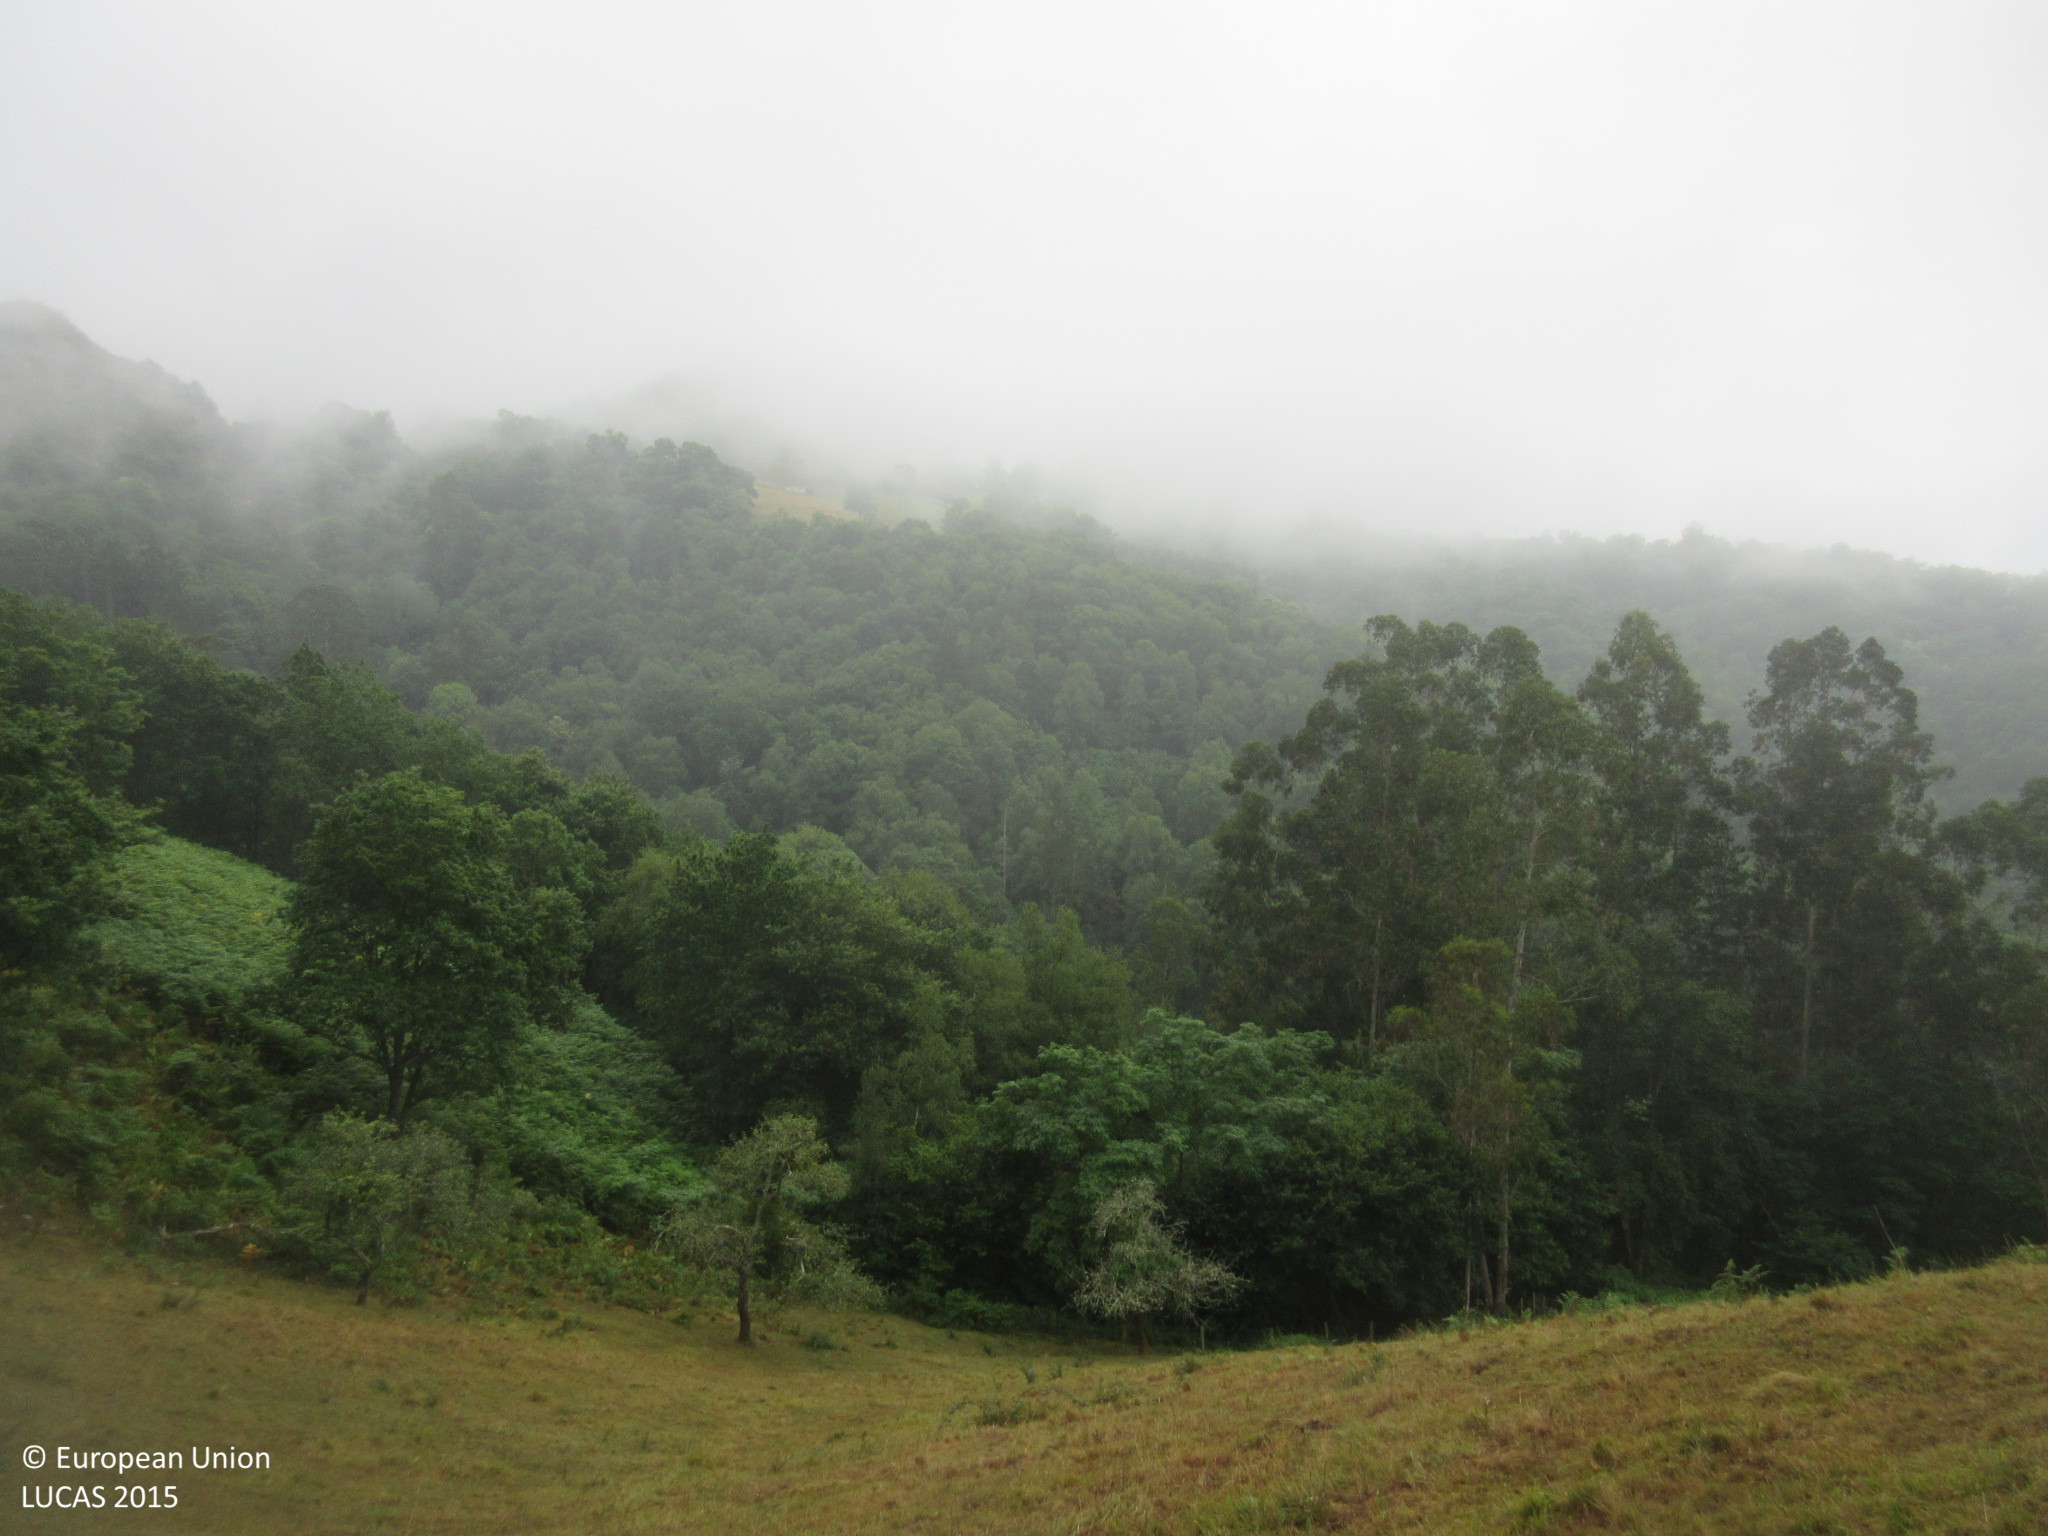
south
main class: Grassland
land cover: Grassland without tree/shrub cover
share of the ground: > 75 %
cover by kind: herbaceous plants 100 %
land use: Agriculture (excluding fallow land and kitchen gardens)
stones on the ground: < 10 %
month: July
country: ES
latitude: 43.3460
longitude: -5.2355
